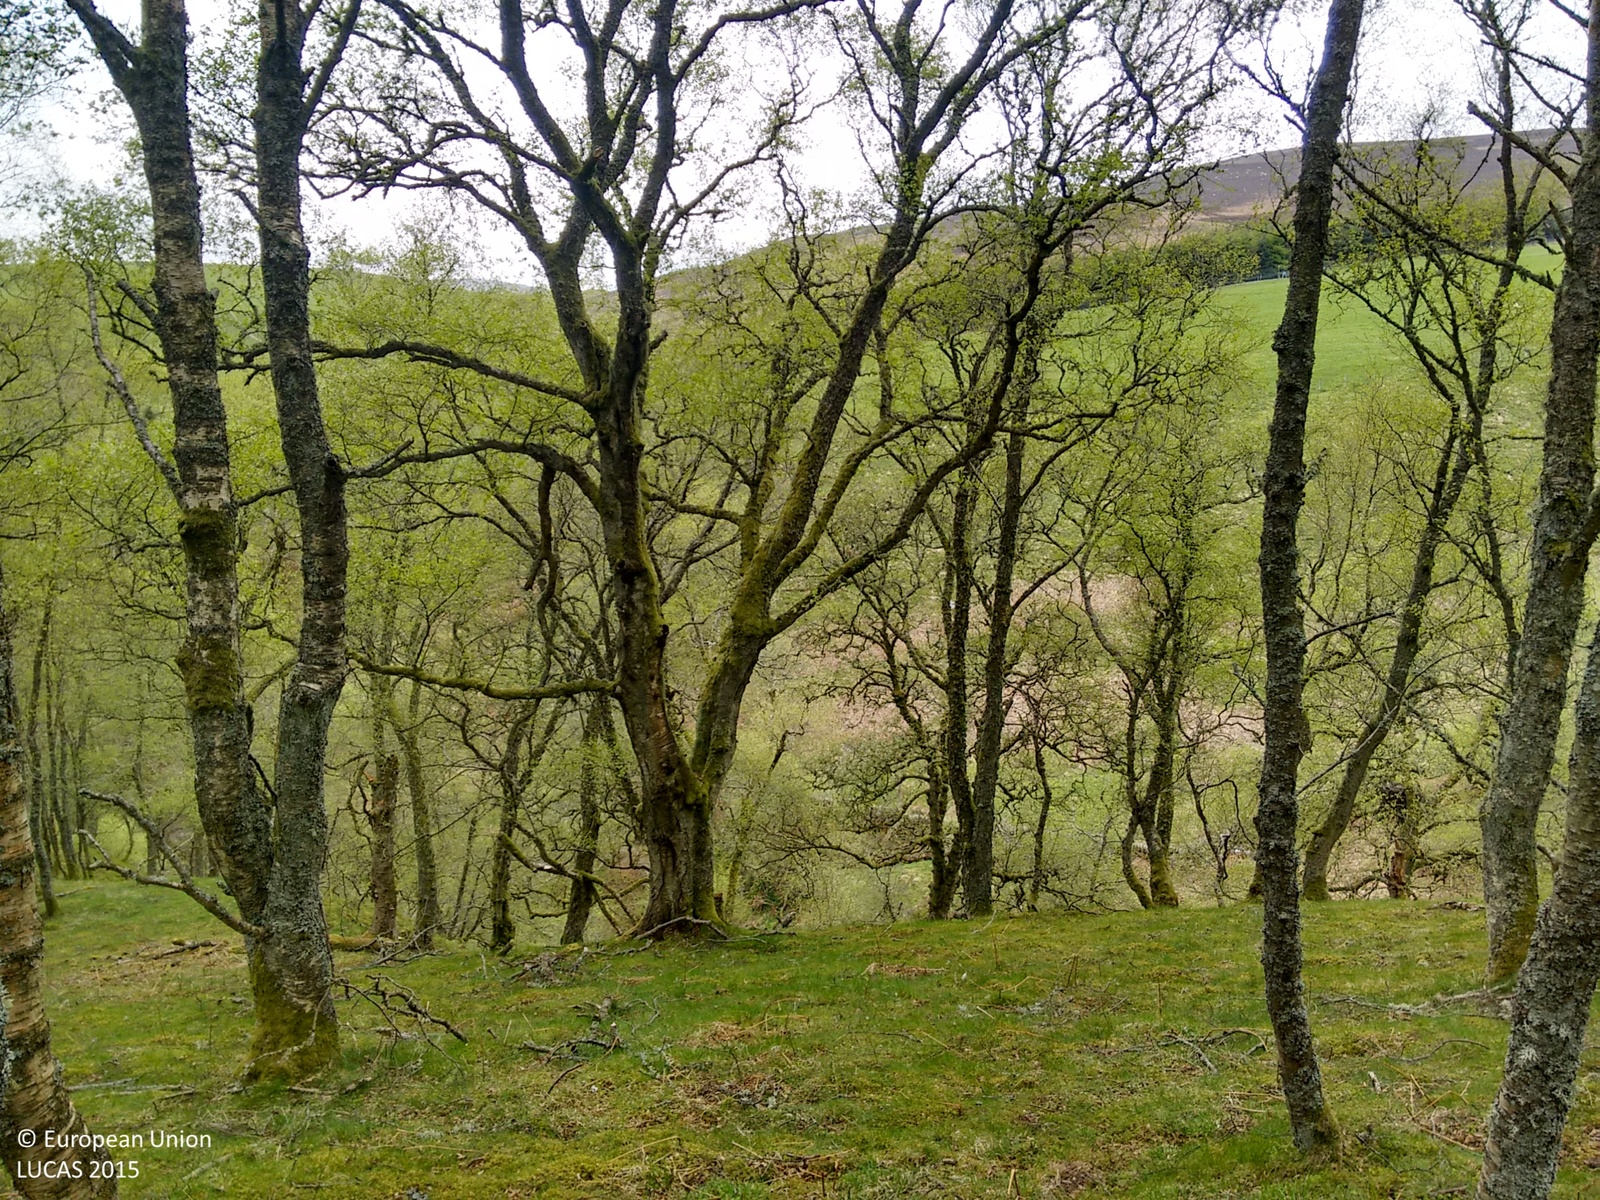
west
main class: Woodland
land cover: Broadleaved woodland
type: non-riverine alder, birch or aspen forest
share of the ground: > 75 %
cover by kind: broadleaved forest trees 85 %, herbaceous plants 10 %, lichens and mosses 5 %
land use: Semi-natural and natural areas not in use
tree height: > 5 m
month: May
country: GB
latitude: 56.7145
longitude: -3.1209
